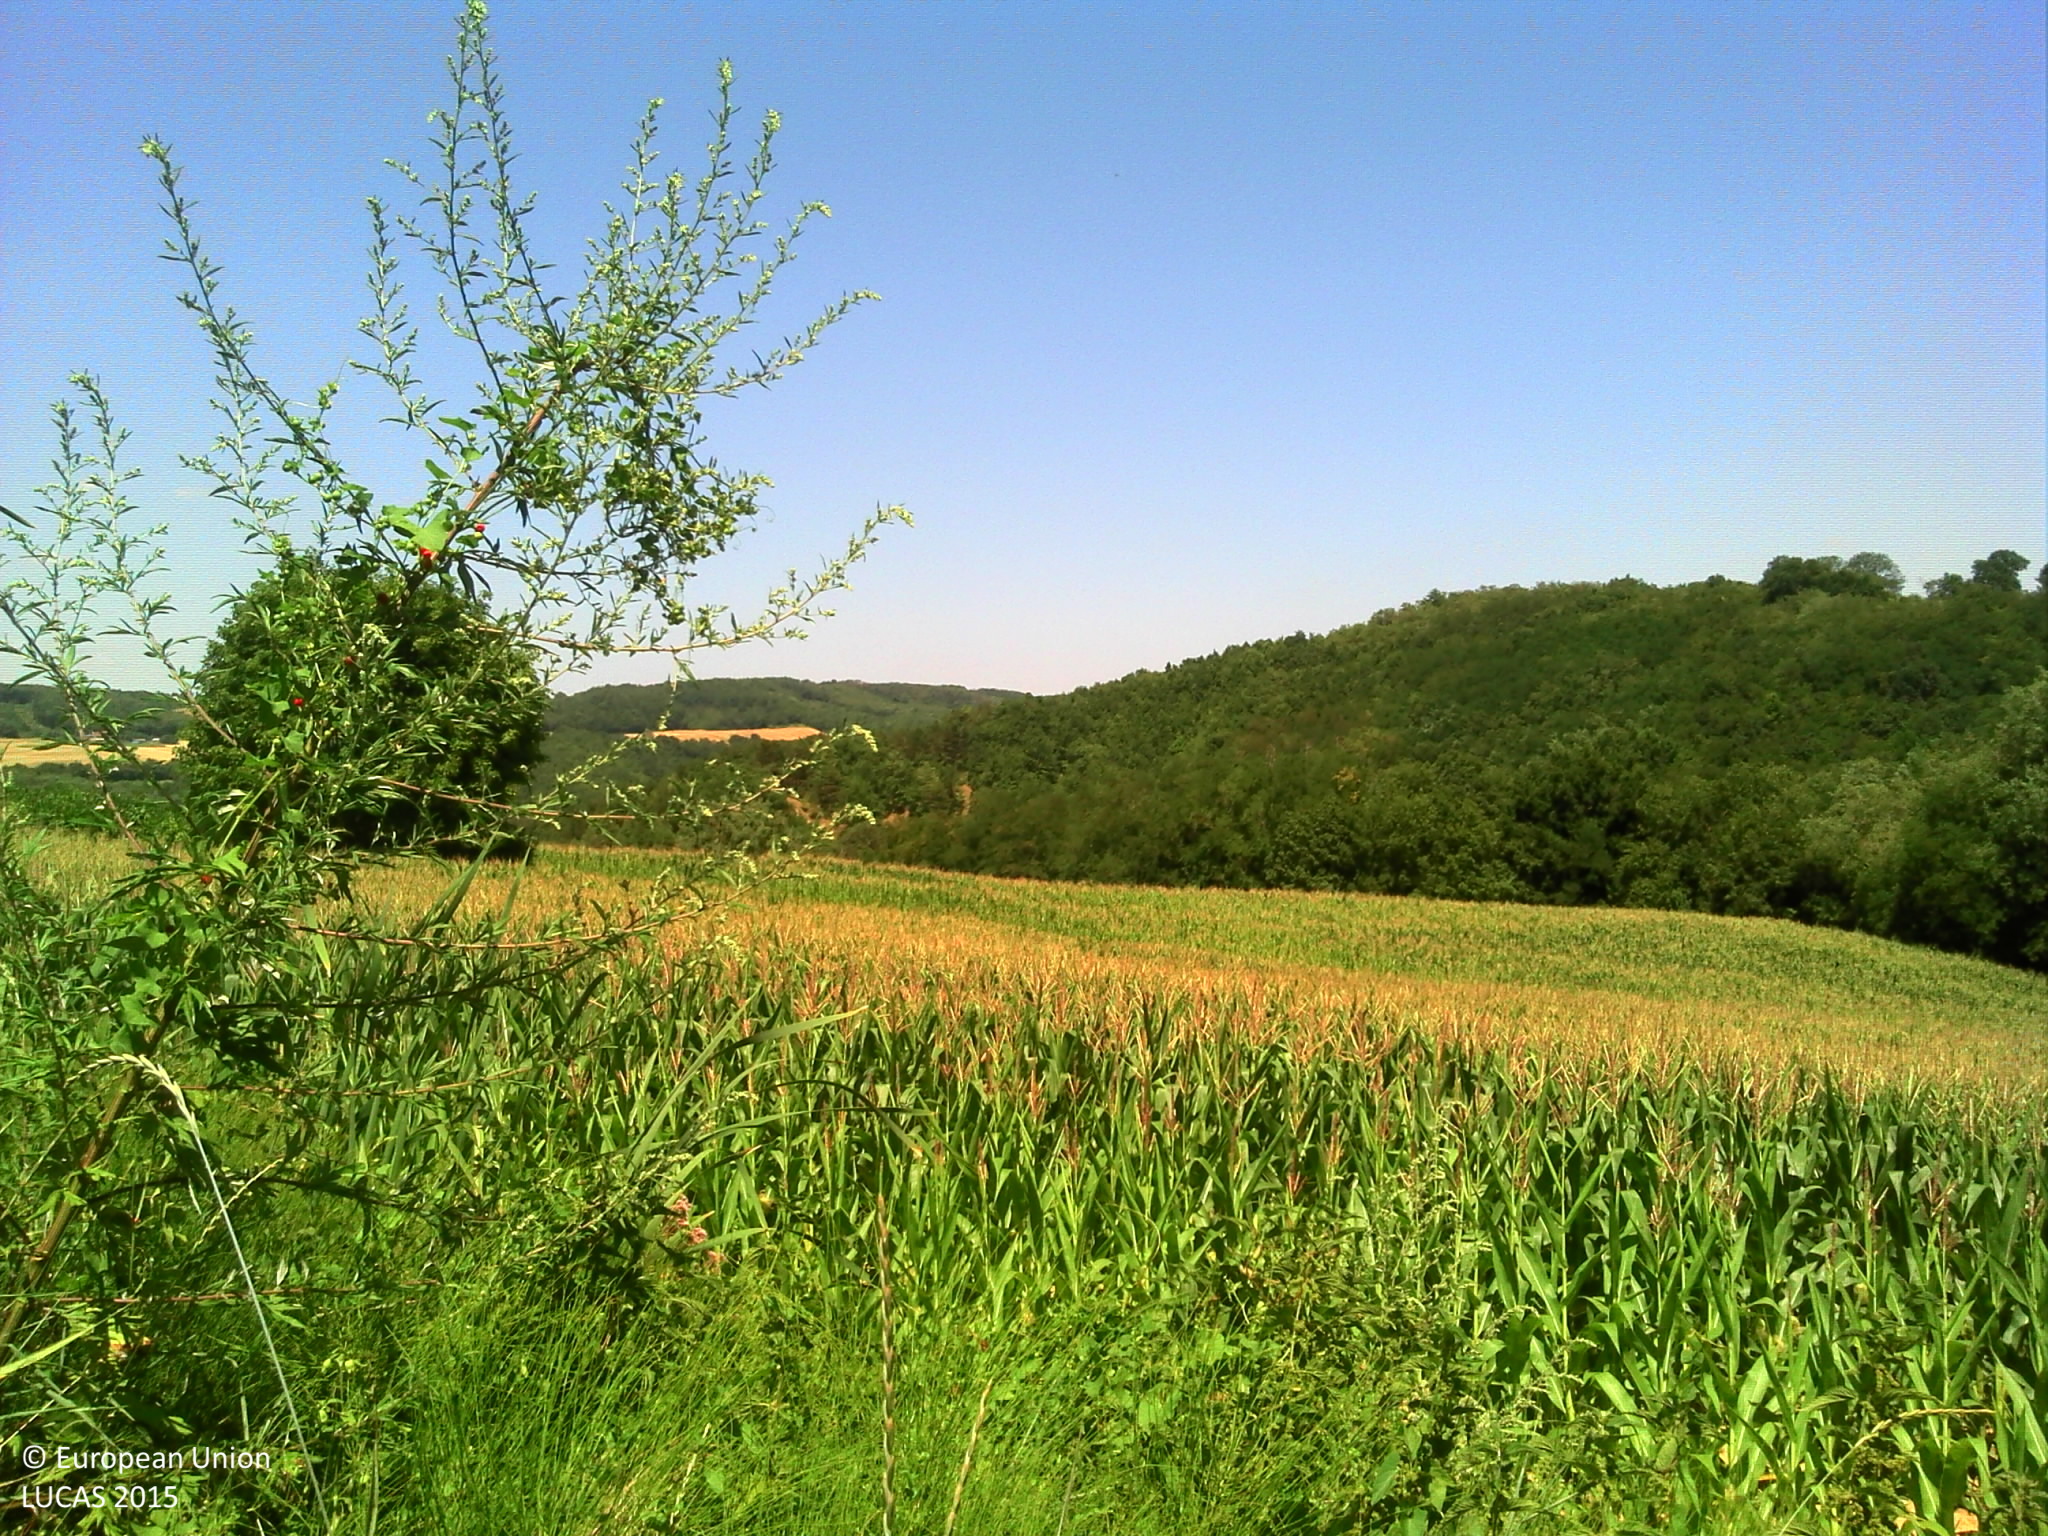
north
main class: Cropland
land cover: Maize
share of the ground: > 75 %
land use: Agriculture (excluding fallow land and kitchen gardens)
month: July
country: FR
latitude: 45.2366
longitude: 4.8968
